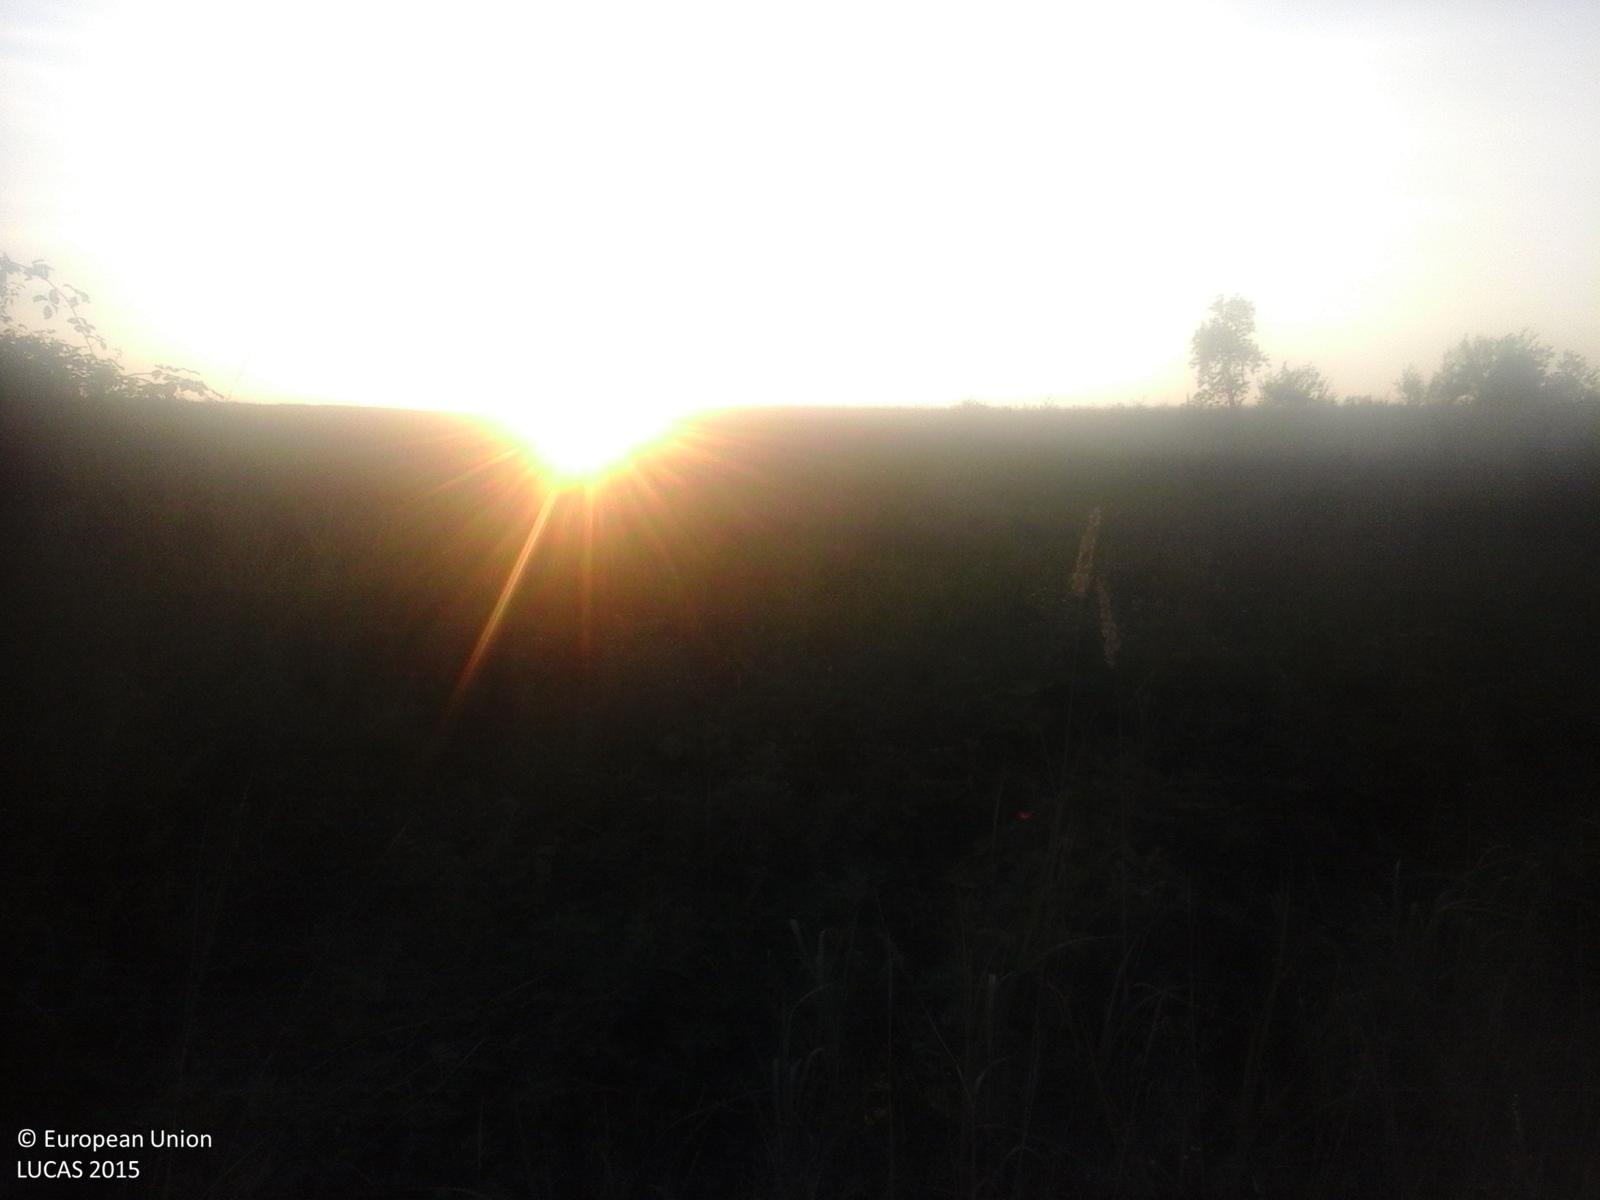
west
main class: Grassland
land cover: Spontaneously vegetated surfaces
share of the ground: > 75 %
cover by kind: herbaceous plants 100 %
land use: Fallow land
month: September
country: RO
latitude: 45.7066
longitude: 22.0242
